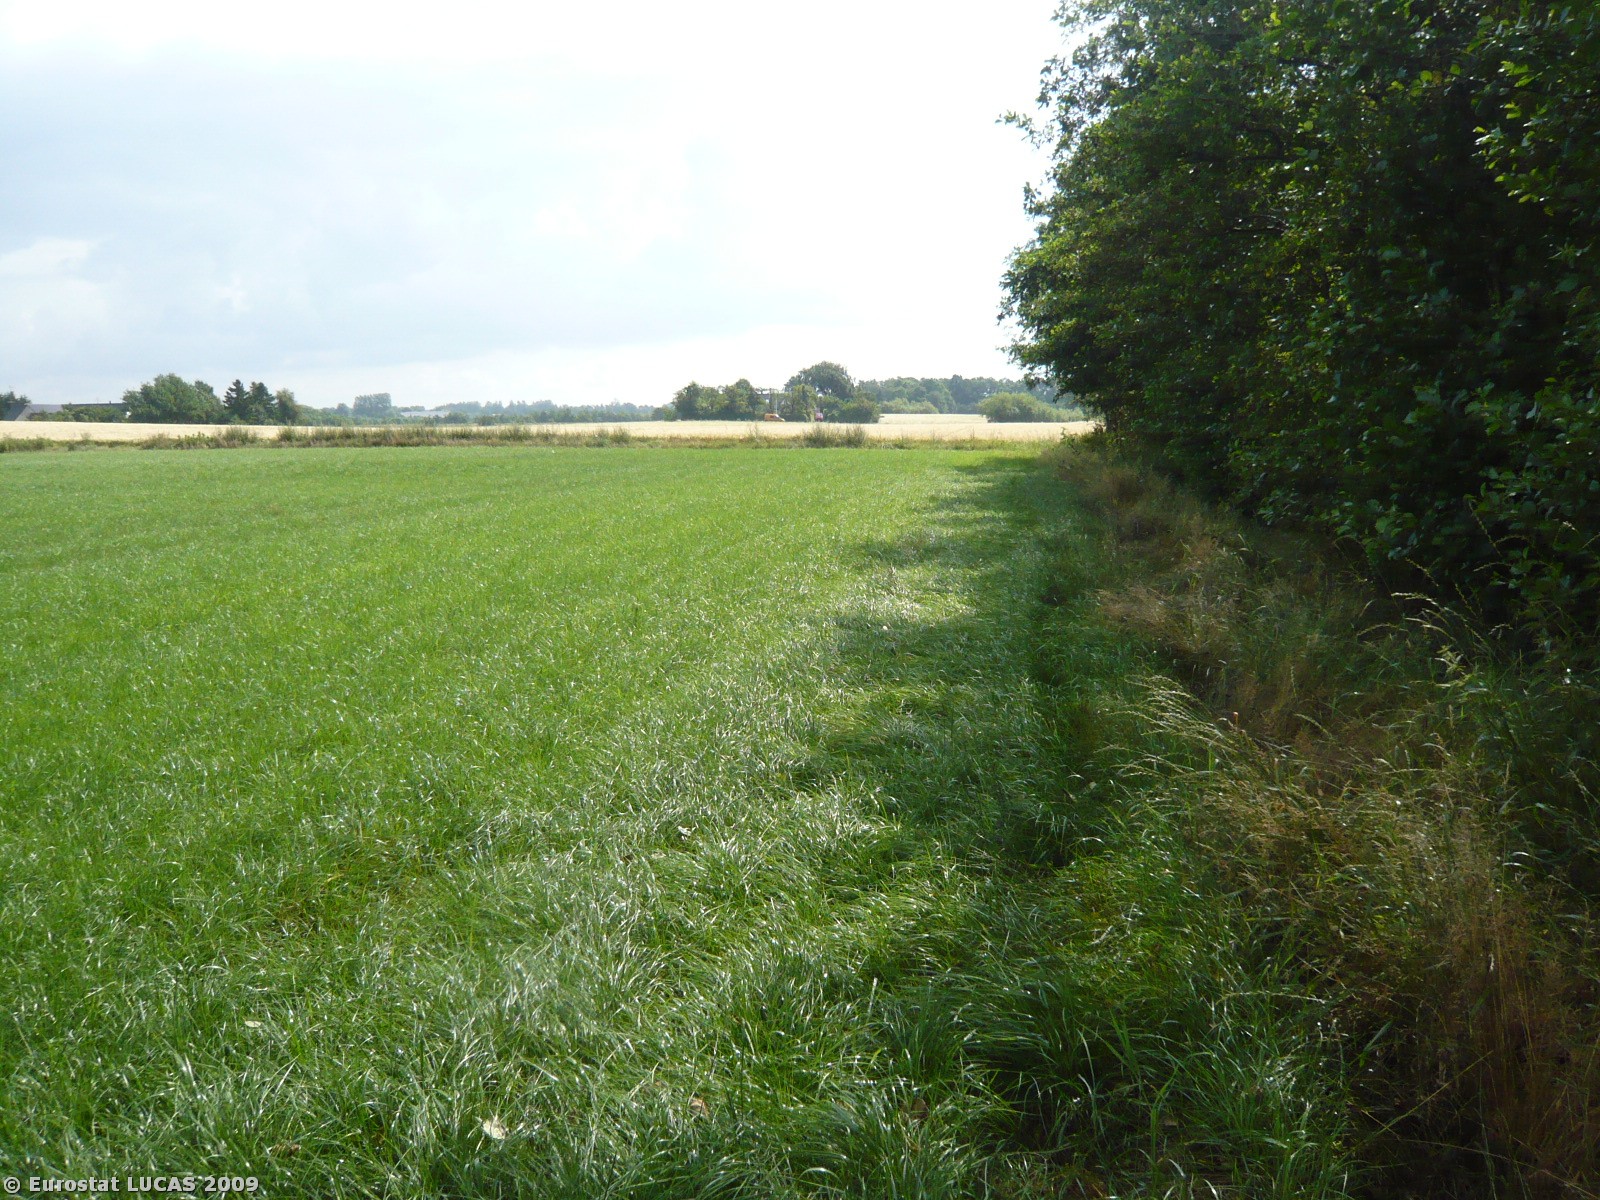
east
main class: Grassland
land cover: Grassland without tree/shrub cover
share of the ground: > 75 %
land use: Agriculture (excluding fallow land and kitchen gardens)
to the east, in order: Grassland without tree/shrub cover; Grass margins; Barley
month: July
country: DK
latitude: 55.5956
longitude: 12.0771
